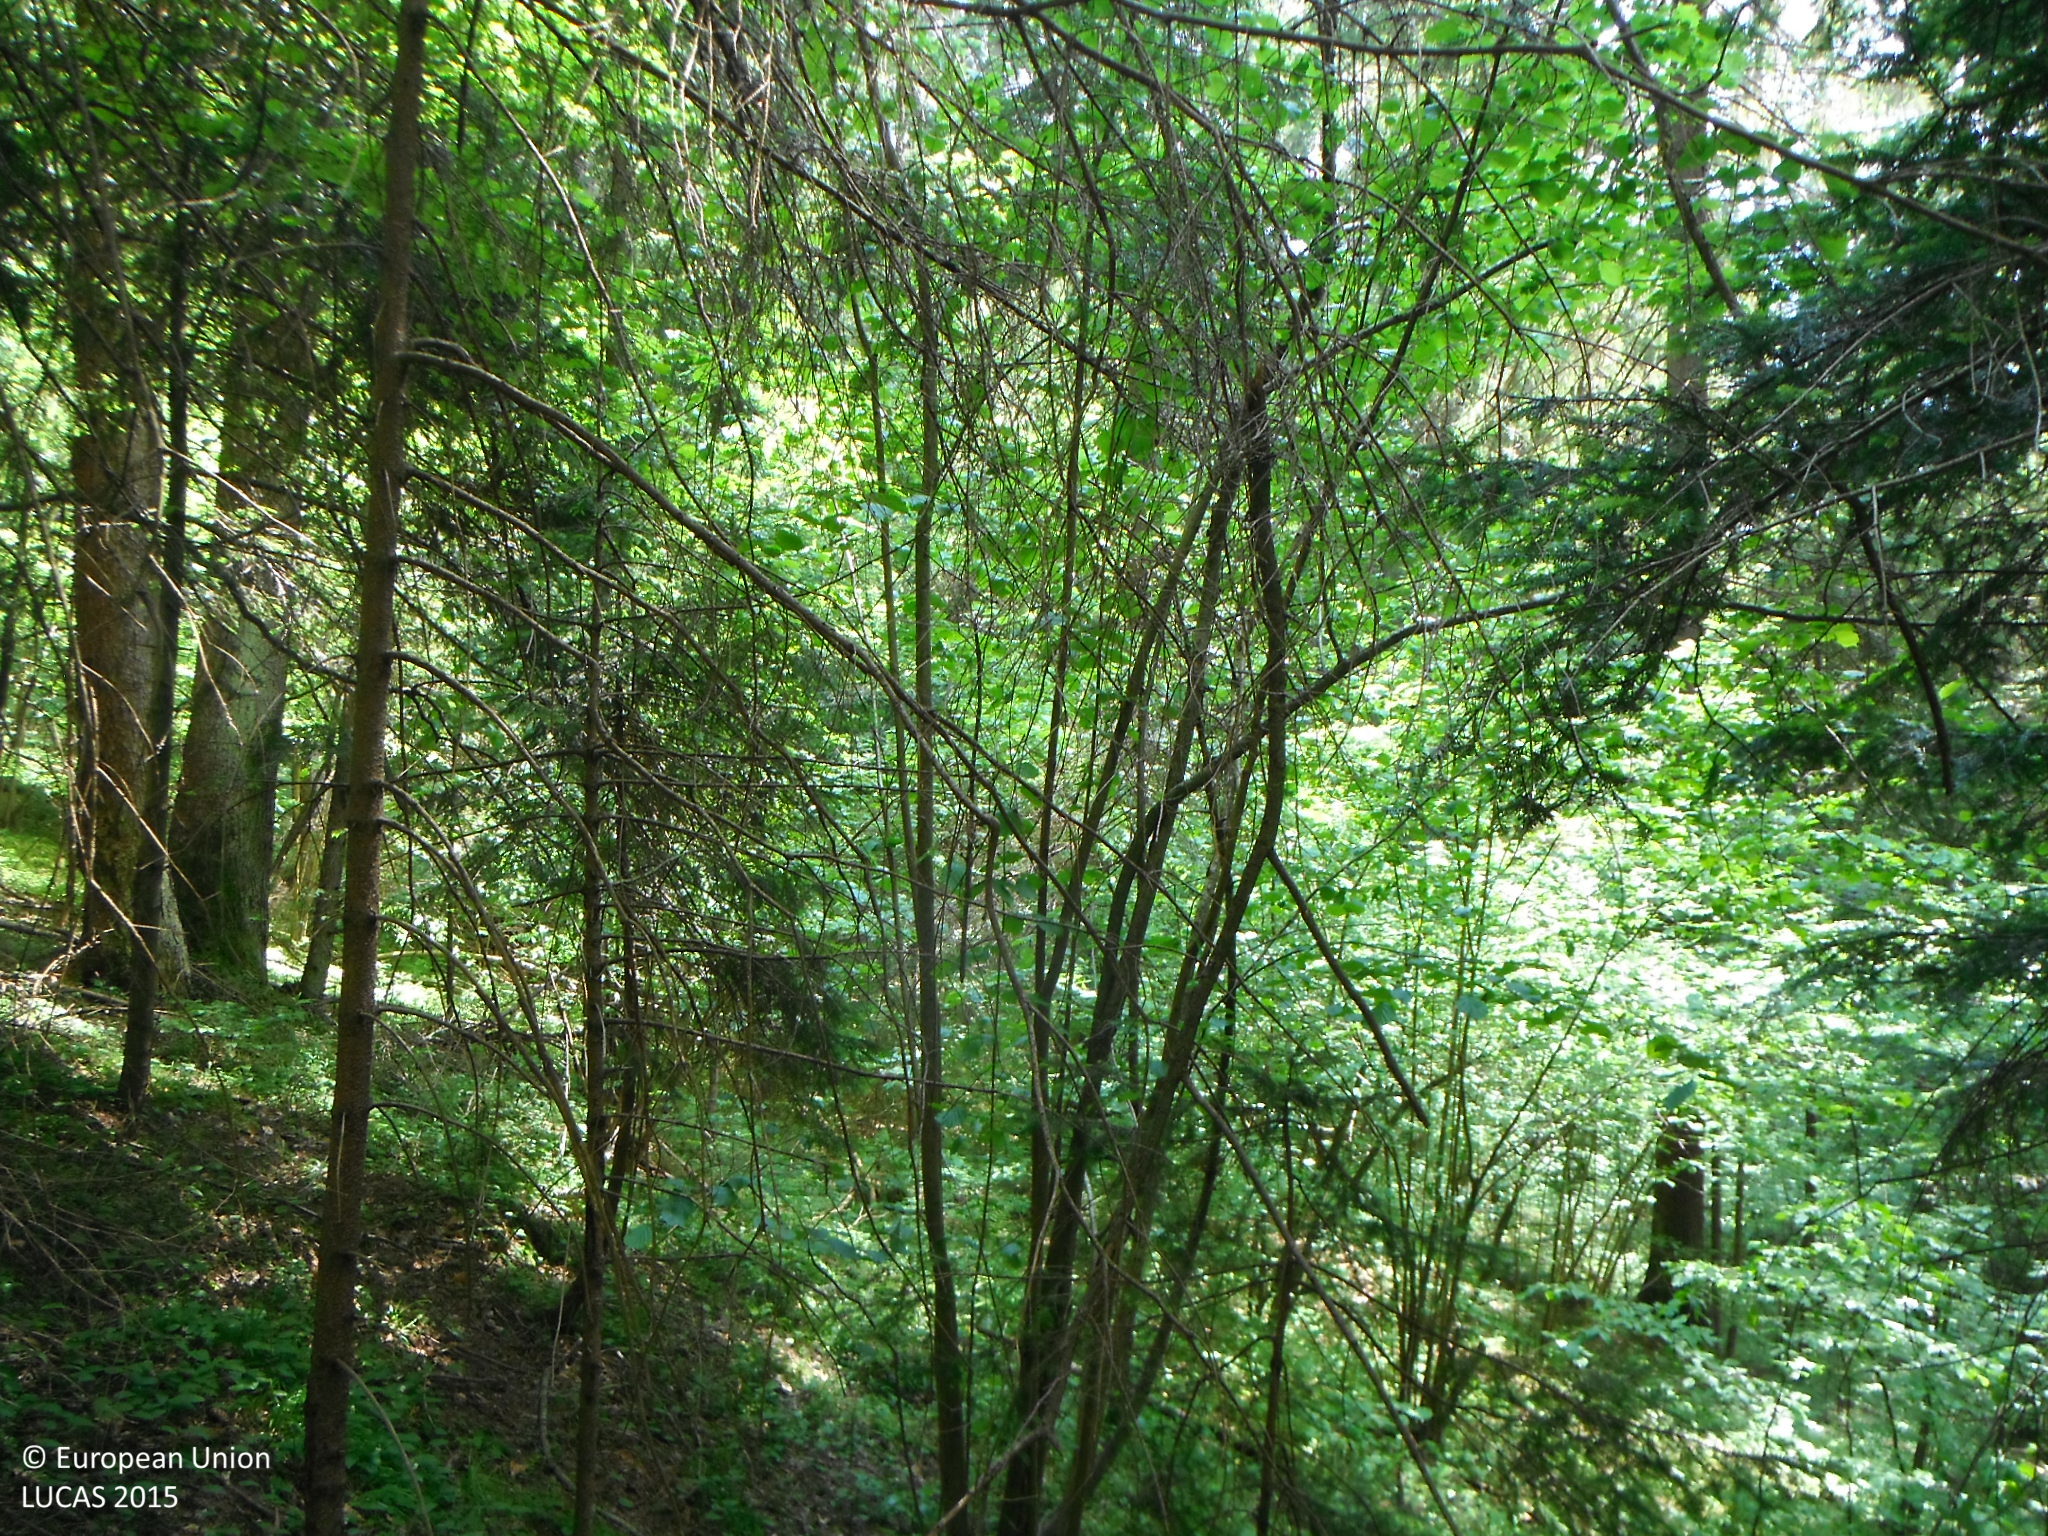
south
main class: Woodland
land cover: Spruce dominated coniferous woodland
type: alpine coniferous forest
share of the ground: > 75 %
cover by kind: coniferous forest trees 90 %, broadleaved forest trees 10 %
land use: Forestry
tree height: > 5 m
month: June
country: SK
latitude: 48.7826
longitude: 19.5939
